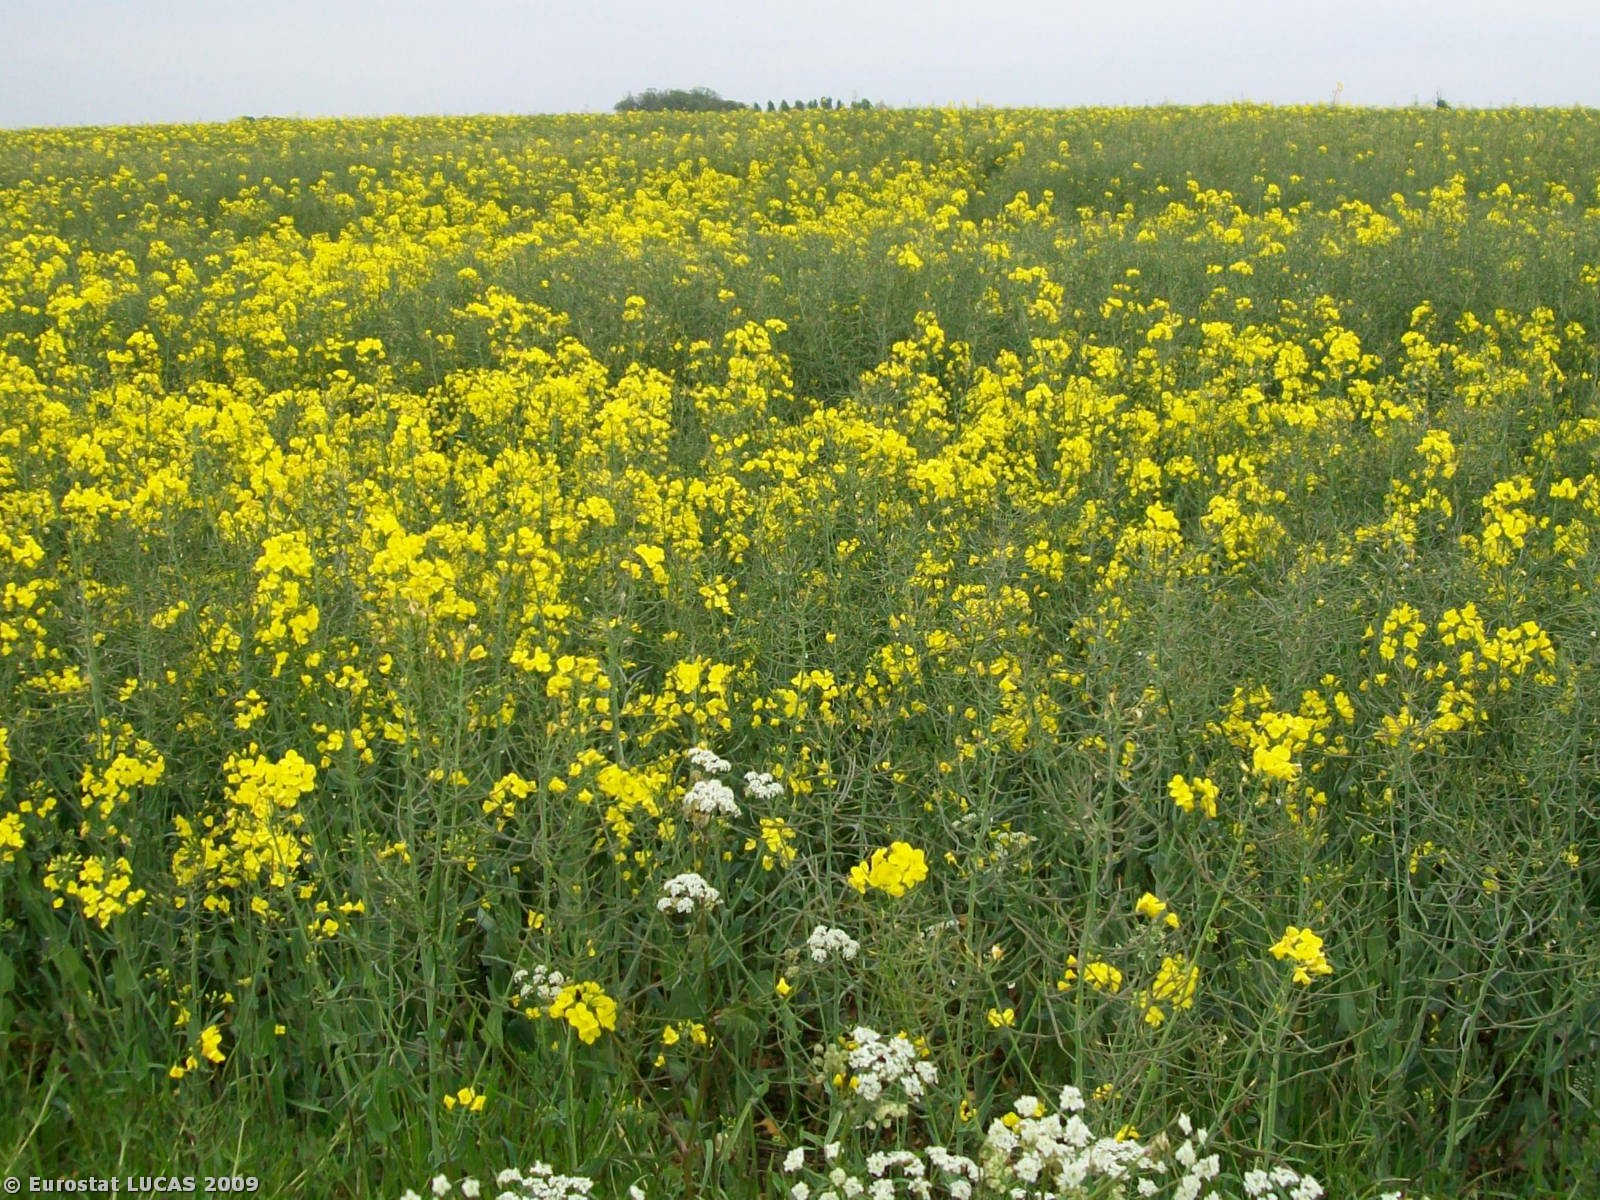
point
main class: Cropland
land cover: Rape and turnip rape
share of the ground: > 75 %
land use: Agriculture (excluding fallow land and kitchen gardens)
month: May
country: GB
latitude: 52.7680
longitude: -0.8467
